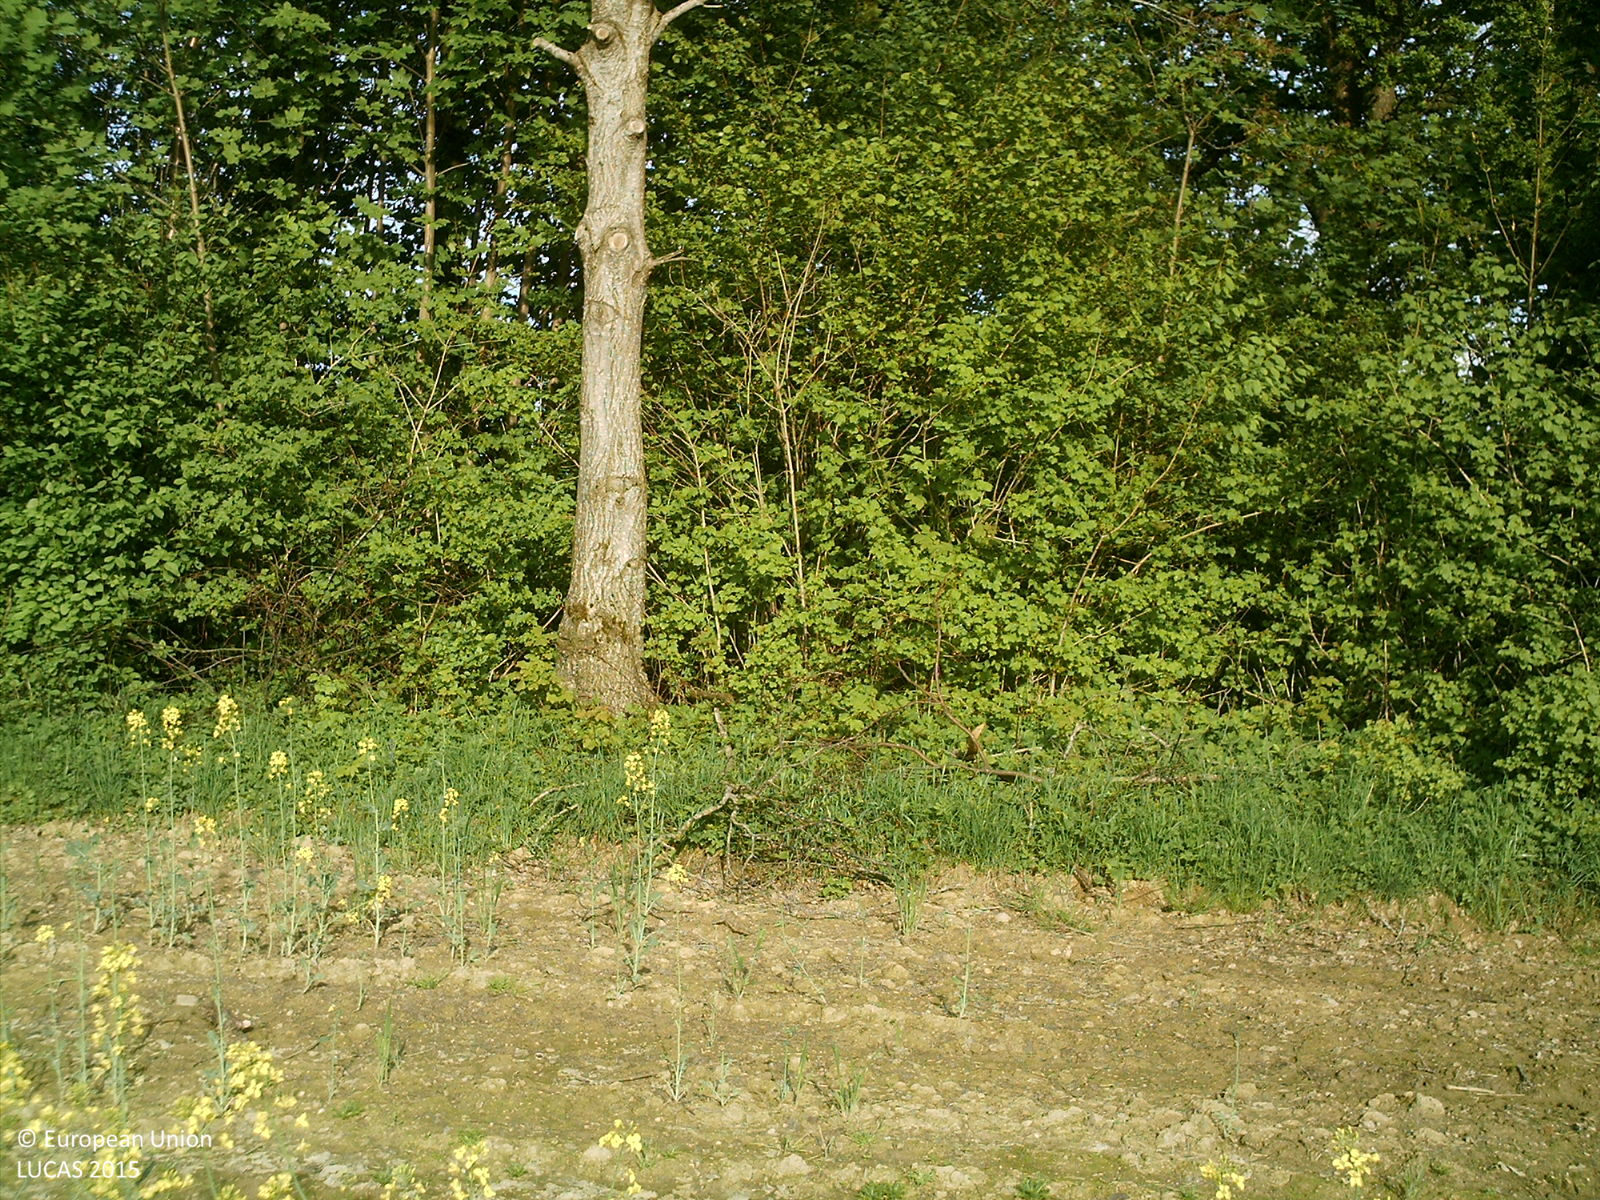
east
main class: Cropland
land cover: Rape and turnip rape
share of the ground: > 75 %
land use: Agriculture (excluding fallow land and kitchen gardens)
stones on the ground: < 10 %
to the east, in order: Rape and turnip rape; Grass margins; Broadleaved woodland; Temporary grasslands; Maize; Tracks; Grassland without tree/shrub cover; Tracks; Maize
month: May
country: AT
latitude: 47.9697
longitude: 14.0312
